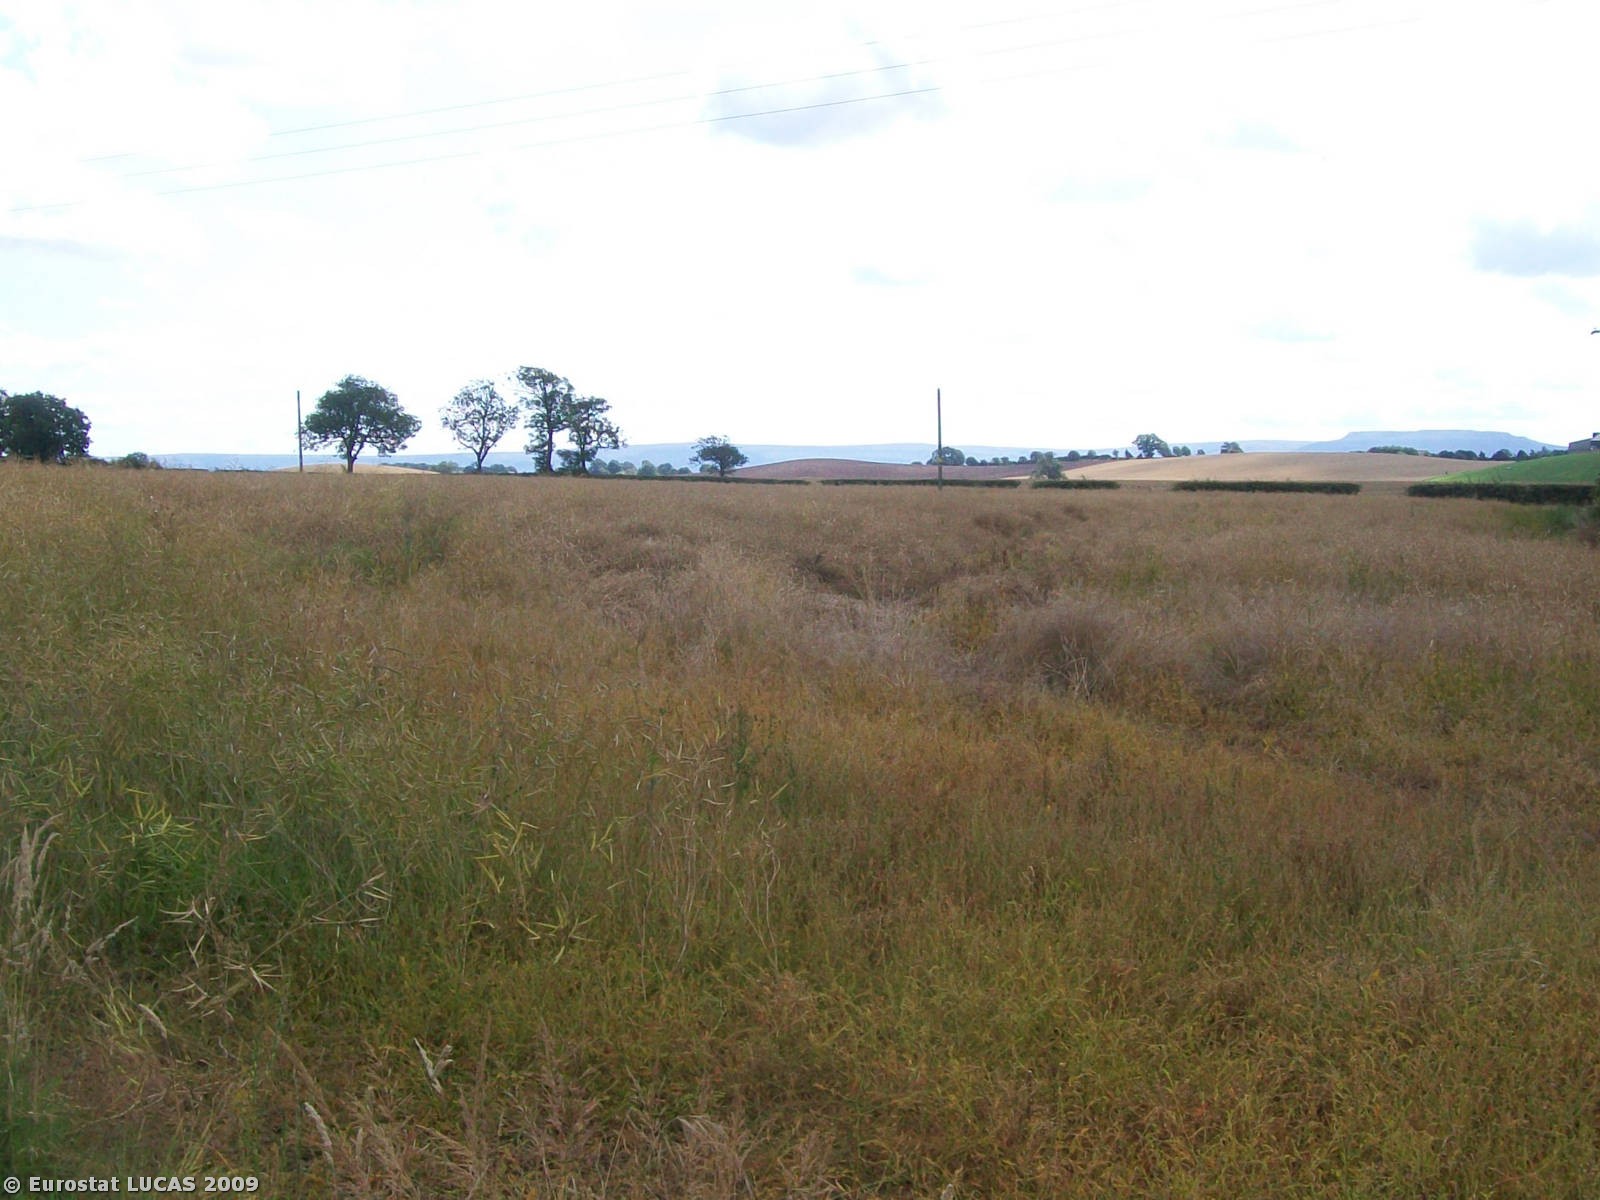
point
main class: Cropland
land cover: Rape and turnip rape
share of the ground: < 10 %
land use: Agriculture (excluding fallow land and kitchen gardens)
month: August
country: GB
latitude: 54.4933
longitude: -1.2380
